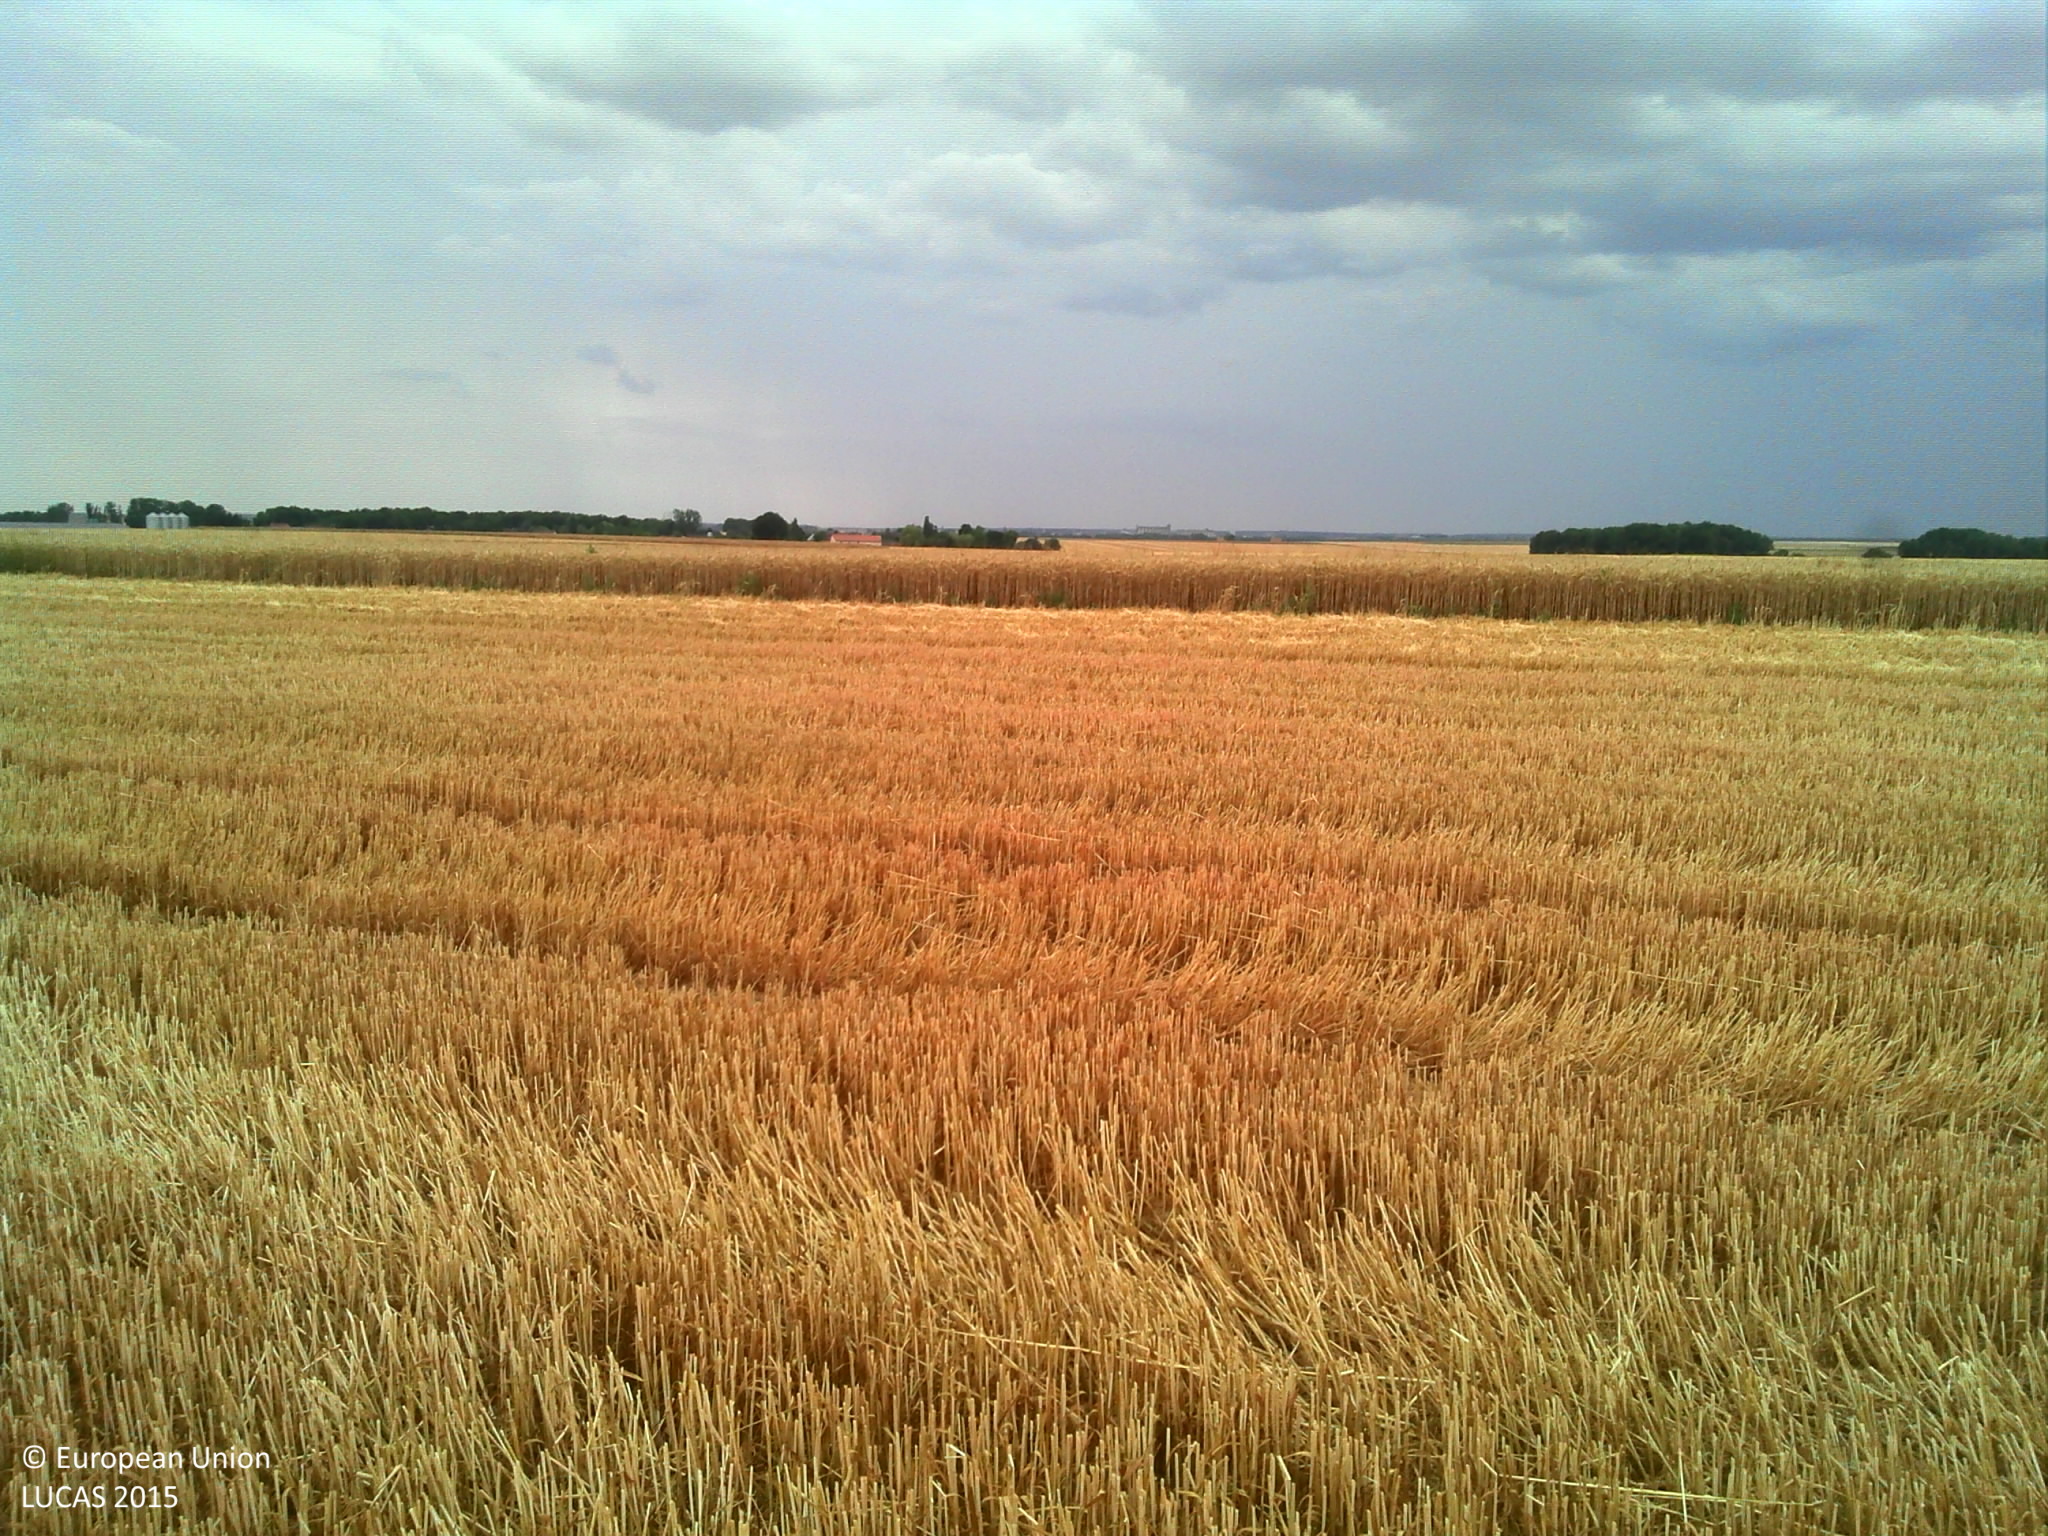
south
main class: Cropland
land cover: Common wheat
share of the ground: > 75 %
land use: Agriculture (excluding fallow land and kitchen gardens)
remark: Harvested field
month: July
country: FR
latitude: 48.4907
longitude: 1.2537
